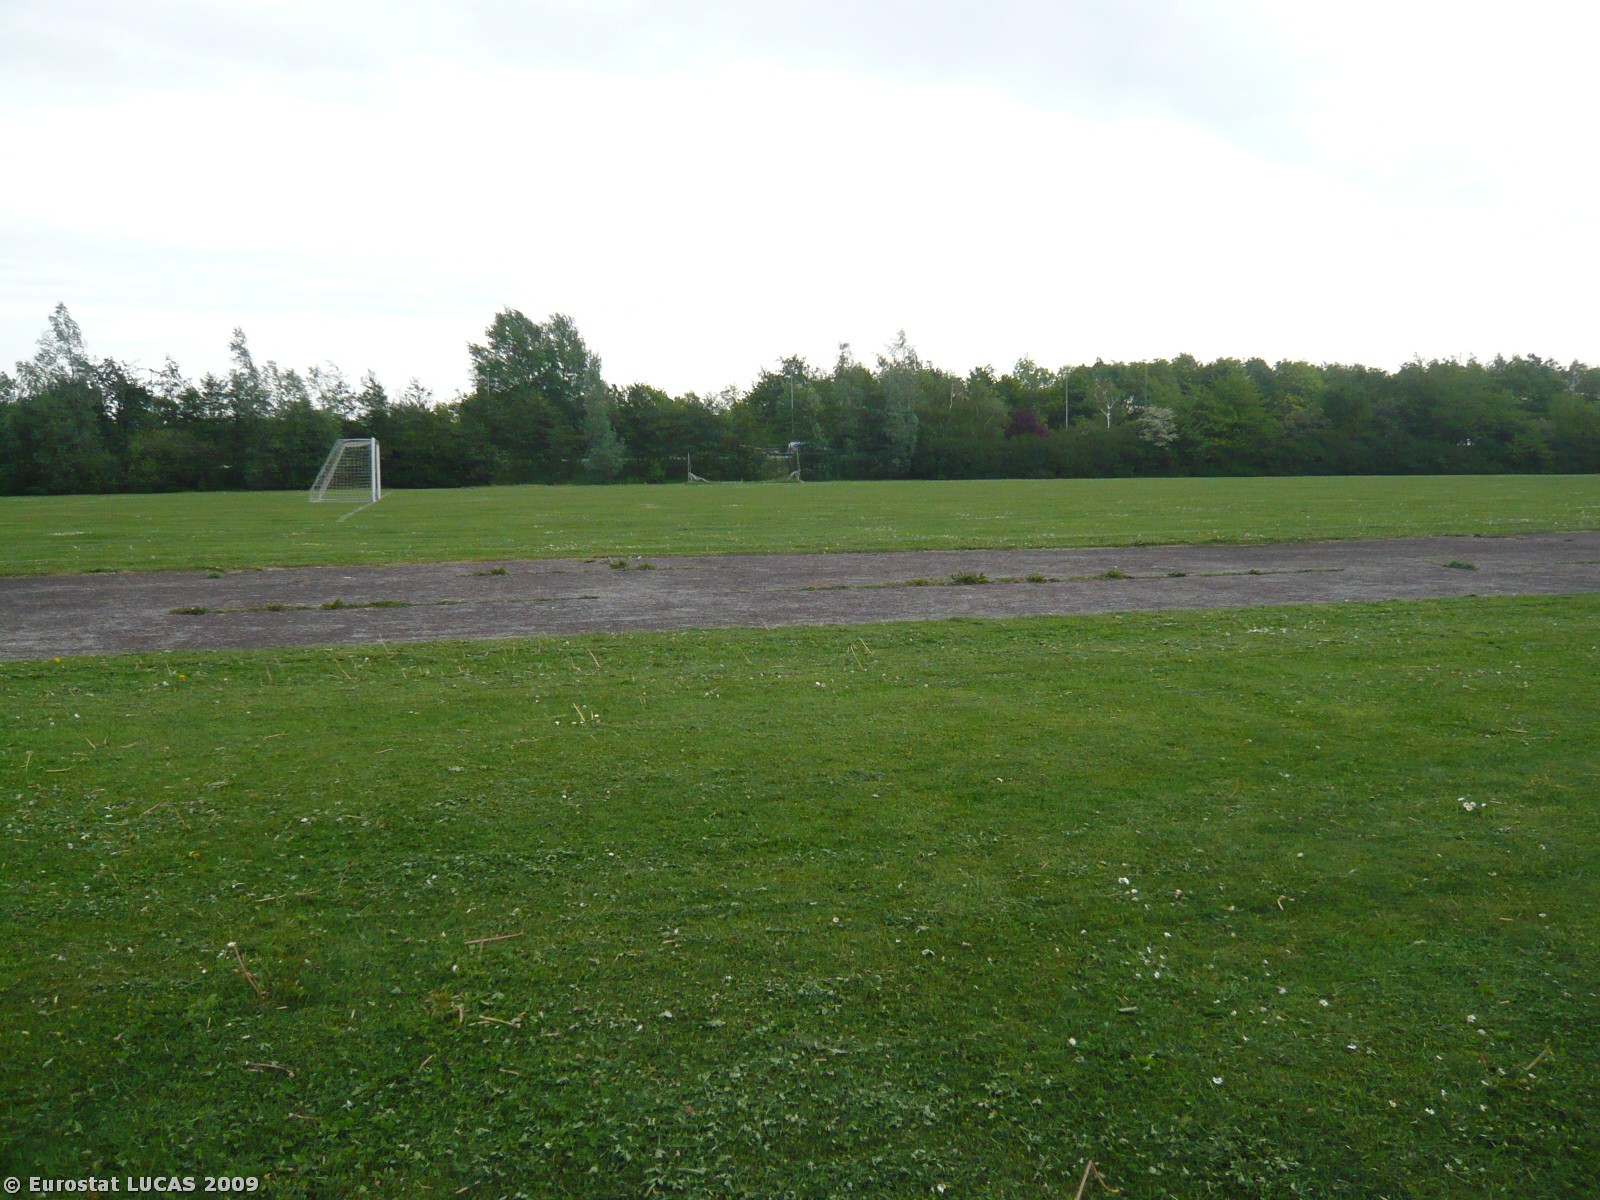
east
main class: Grassland
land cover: Grassland without tree/shrub cover
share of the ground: > 75 %
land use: Sport
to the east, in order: Grassland without tree/shrub cover; Artificial constructions in urban areas; Grassland without tree/shrub cover; Broadleaved woodland; Fences; Tracks; Paved roads, cycling and walking lanes; Grass margins; Broadleaved woodland; Fences; Grassland without tree/shrub cover; Tracks; Grassland without tree/shrub cover; Broadleaved woodland; Fences; Grassland without tree/shrub cover
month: May
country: DK
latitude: 55.2406
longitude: 11.7758
